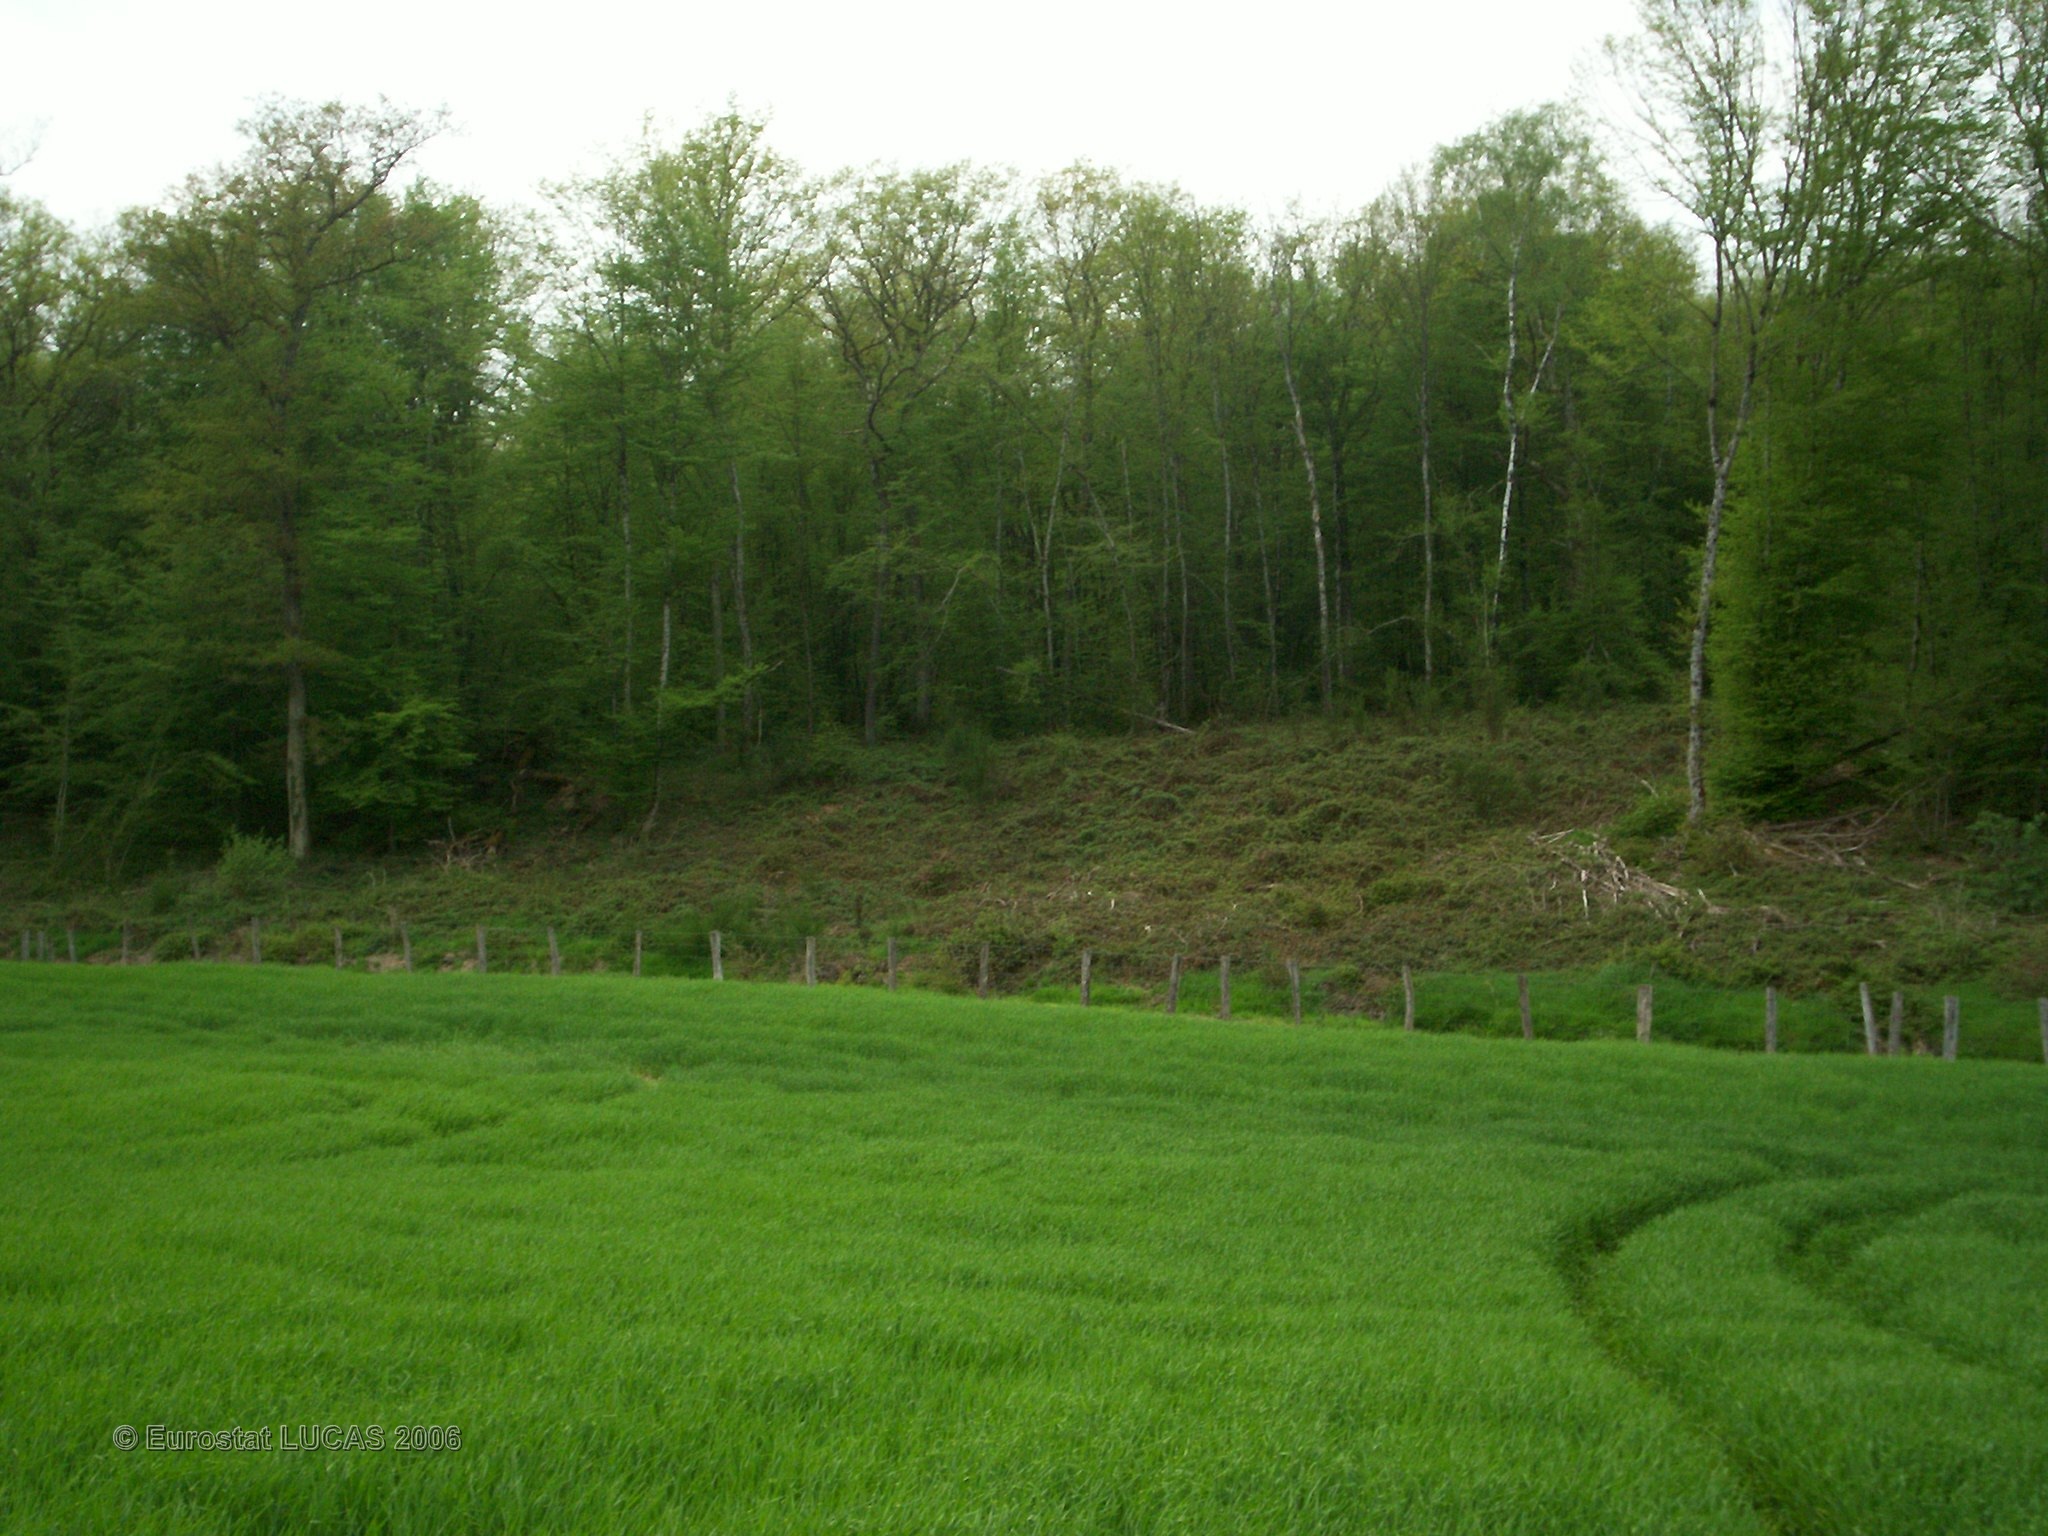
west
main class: Cropland
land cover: Barley
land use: Agriculture (excluding fallow land and kitchen gardens)
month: May
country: FR
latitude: 47.4401
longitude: 3.8847
